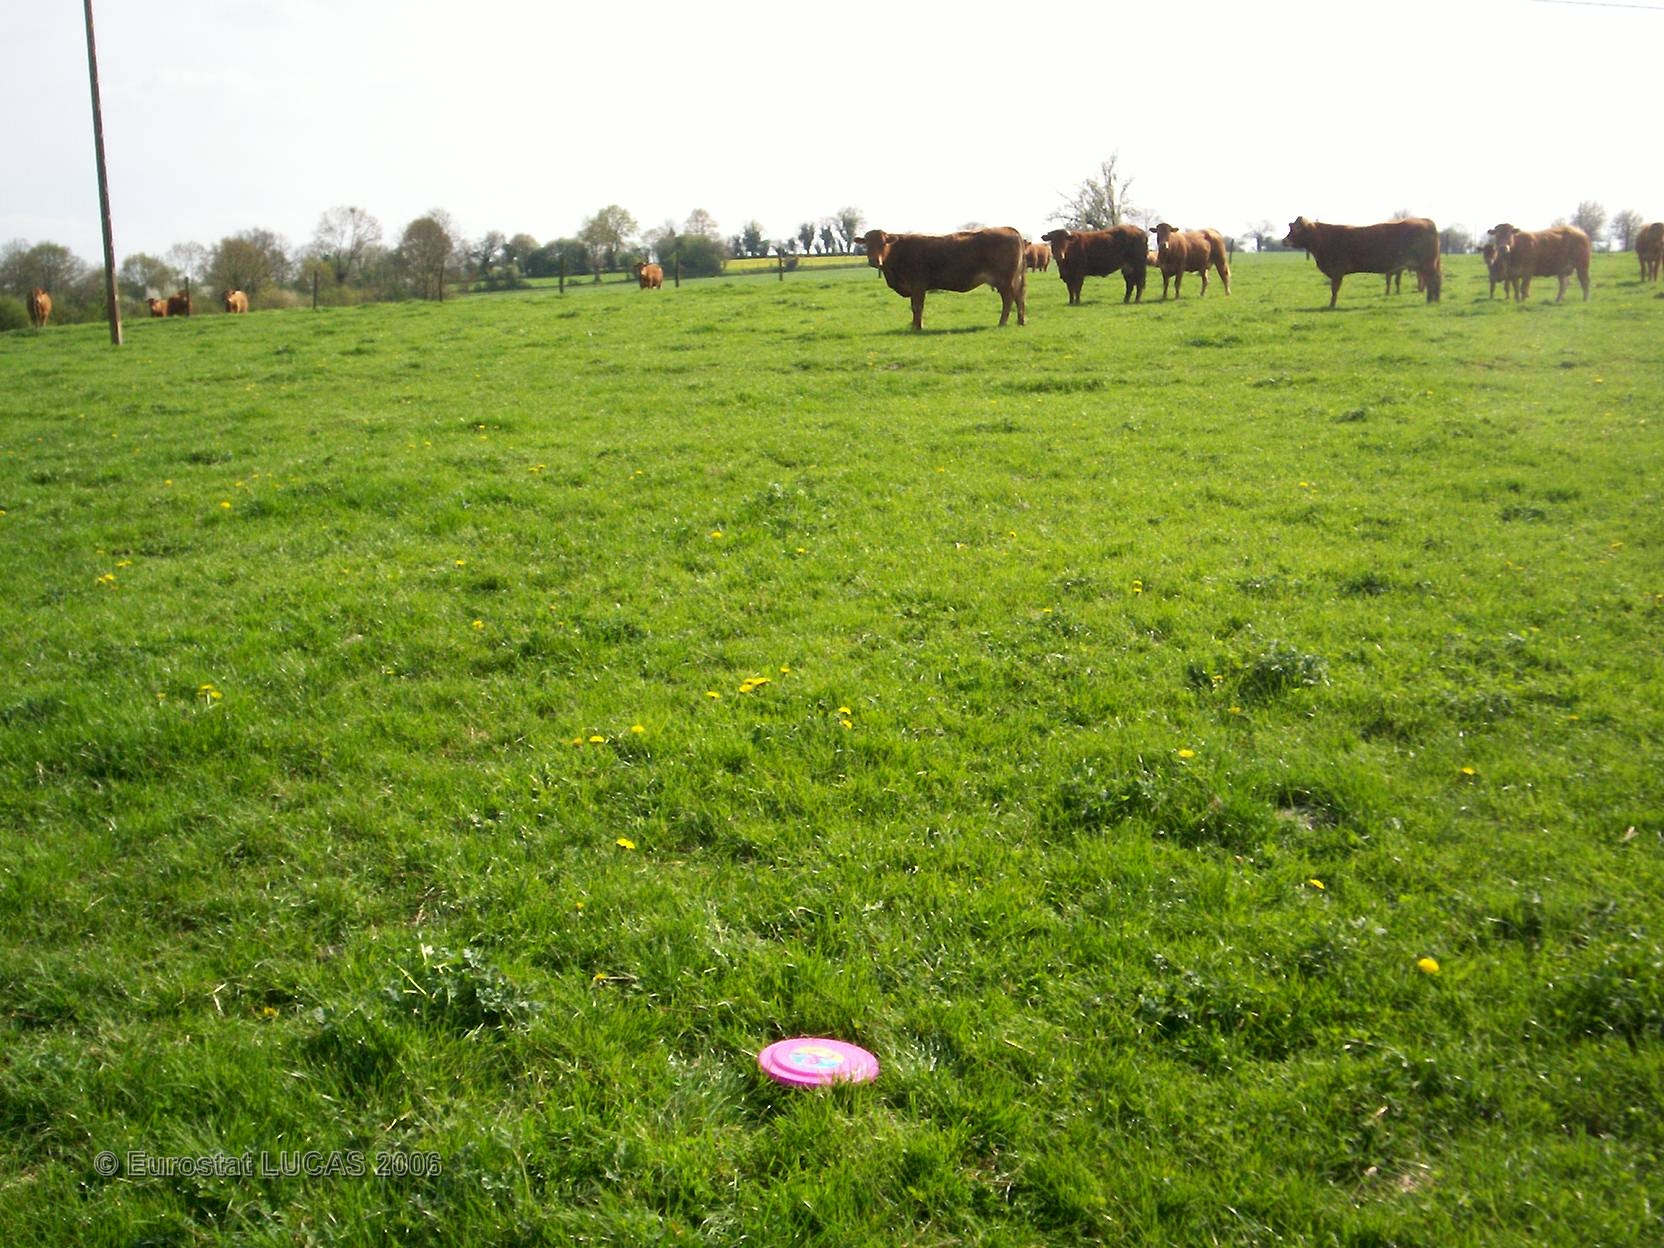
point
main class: Grassland
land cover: Grassland without tree/shrub cover
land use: Agriculture (excluding fallow land and kitchen gardens)
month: April
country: FR
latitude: 48.1452
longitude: -0.2320
